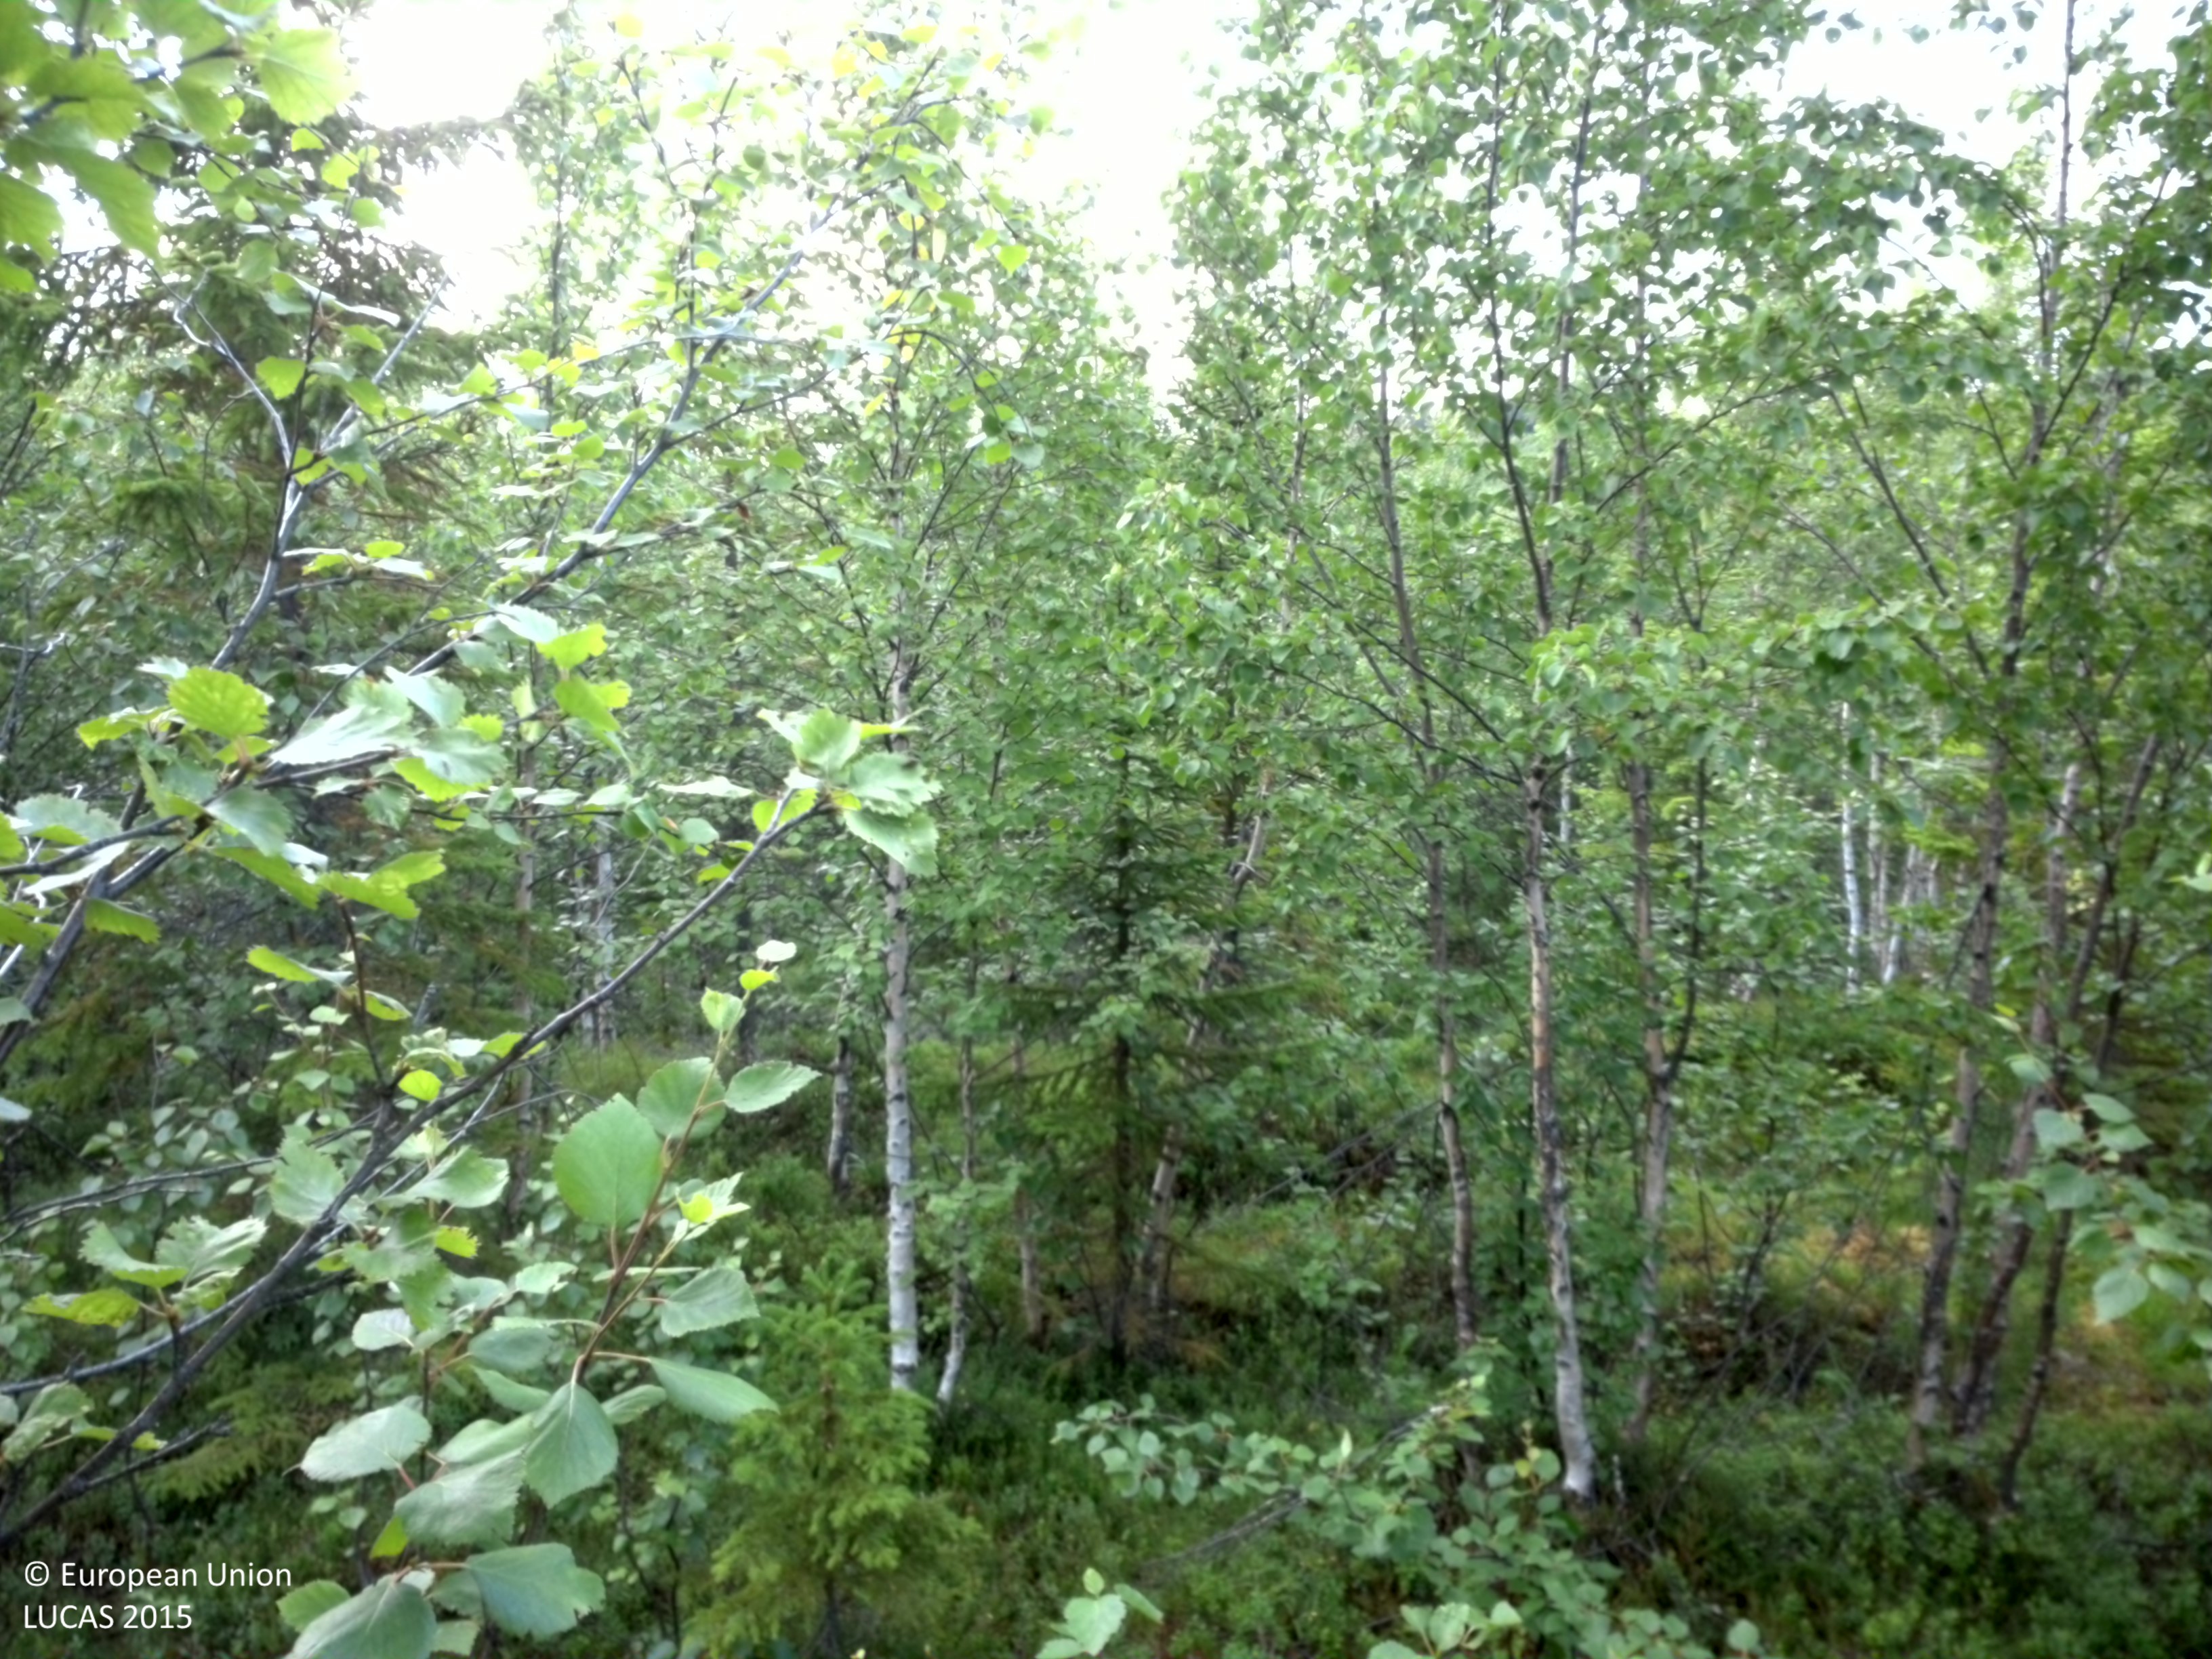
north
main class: Woodland
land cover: Spruce dominated mixed woodland
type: boreal forest
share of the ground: 25 - 50 %
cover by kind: shrubs 55 %, broadleaved forest trees 25 %, coniferous forest trees 10 %, herbaceous plants 5 %, lichens and mosses 5 %
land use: Forestry
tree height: > 5 m
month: August
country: SE
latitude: 64.8621
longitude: 16.0638
